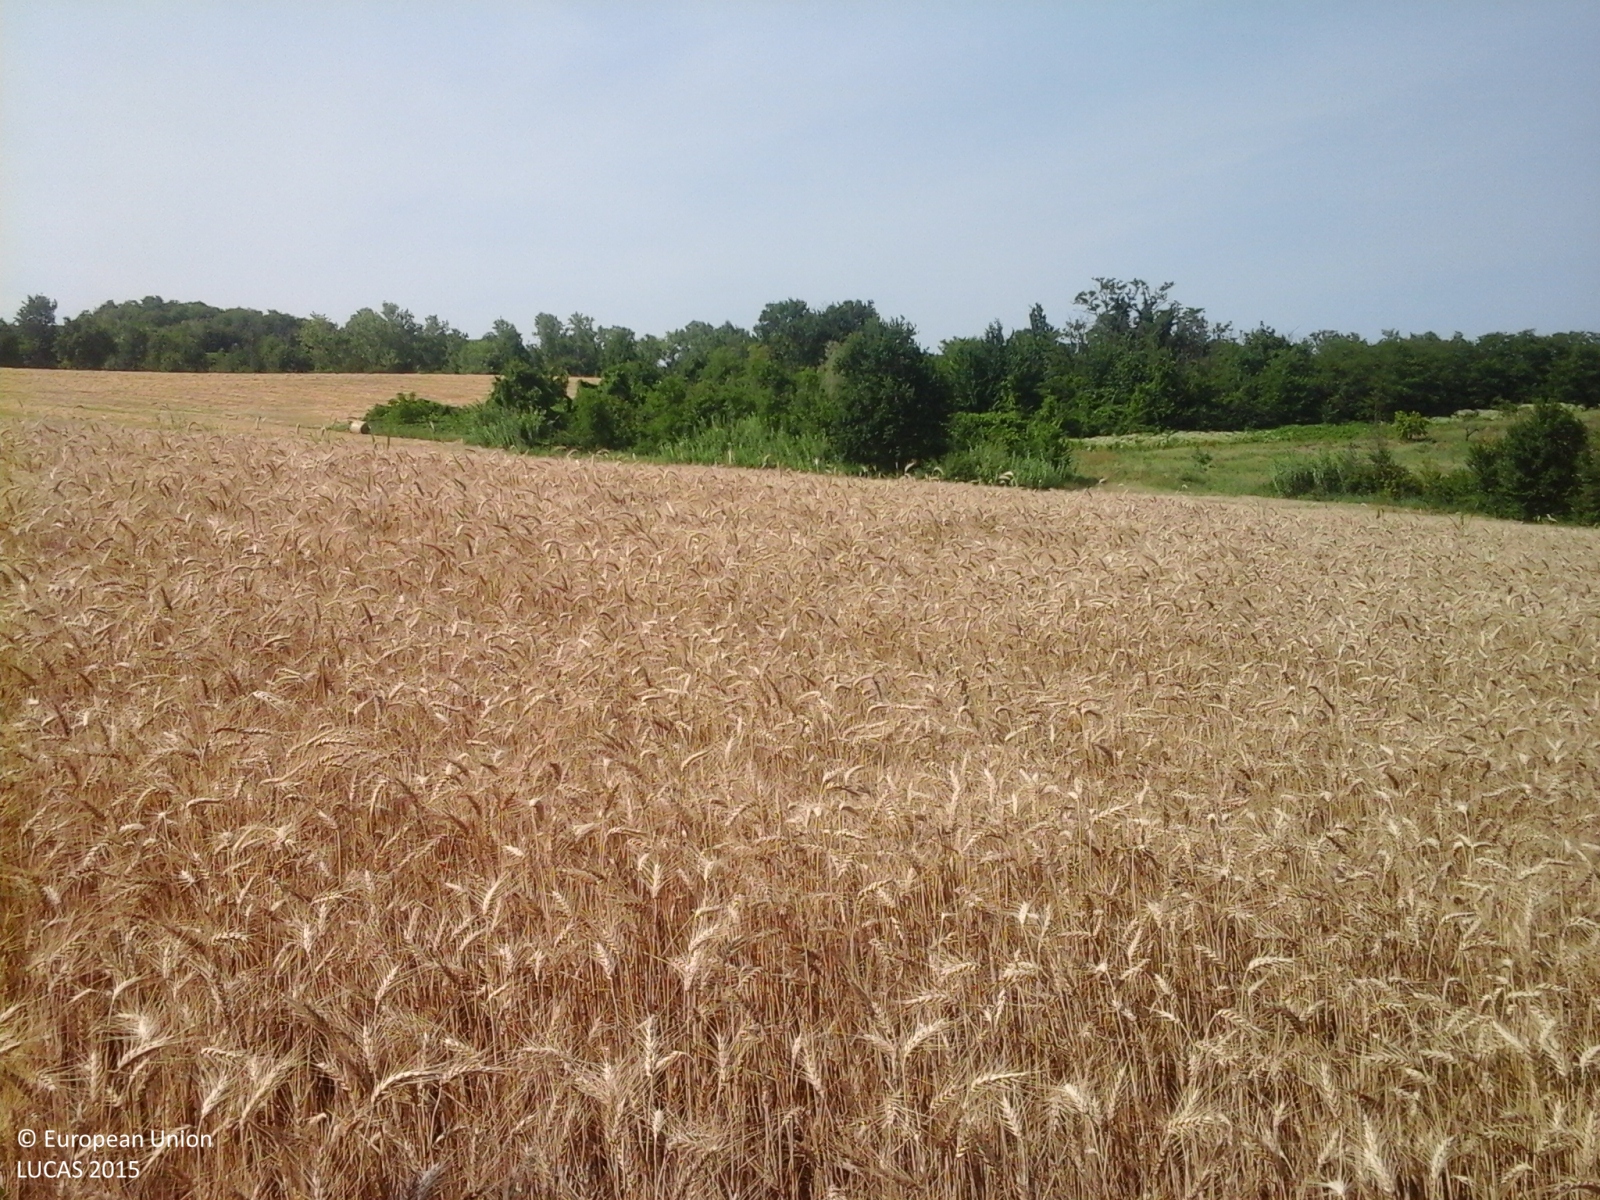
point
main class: Cropland
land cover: Common wheat
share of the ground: > 75 %
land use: Agriculture (excluding fallow land and kitchen gardens)
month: June
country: IT
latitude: 45.0062
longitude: 8.4424
